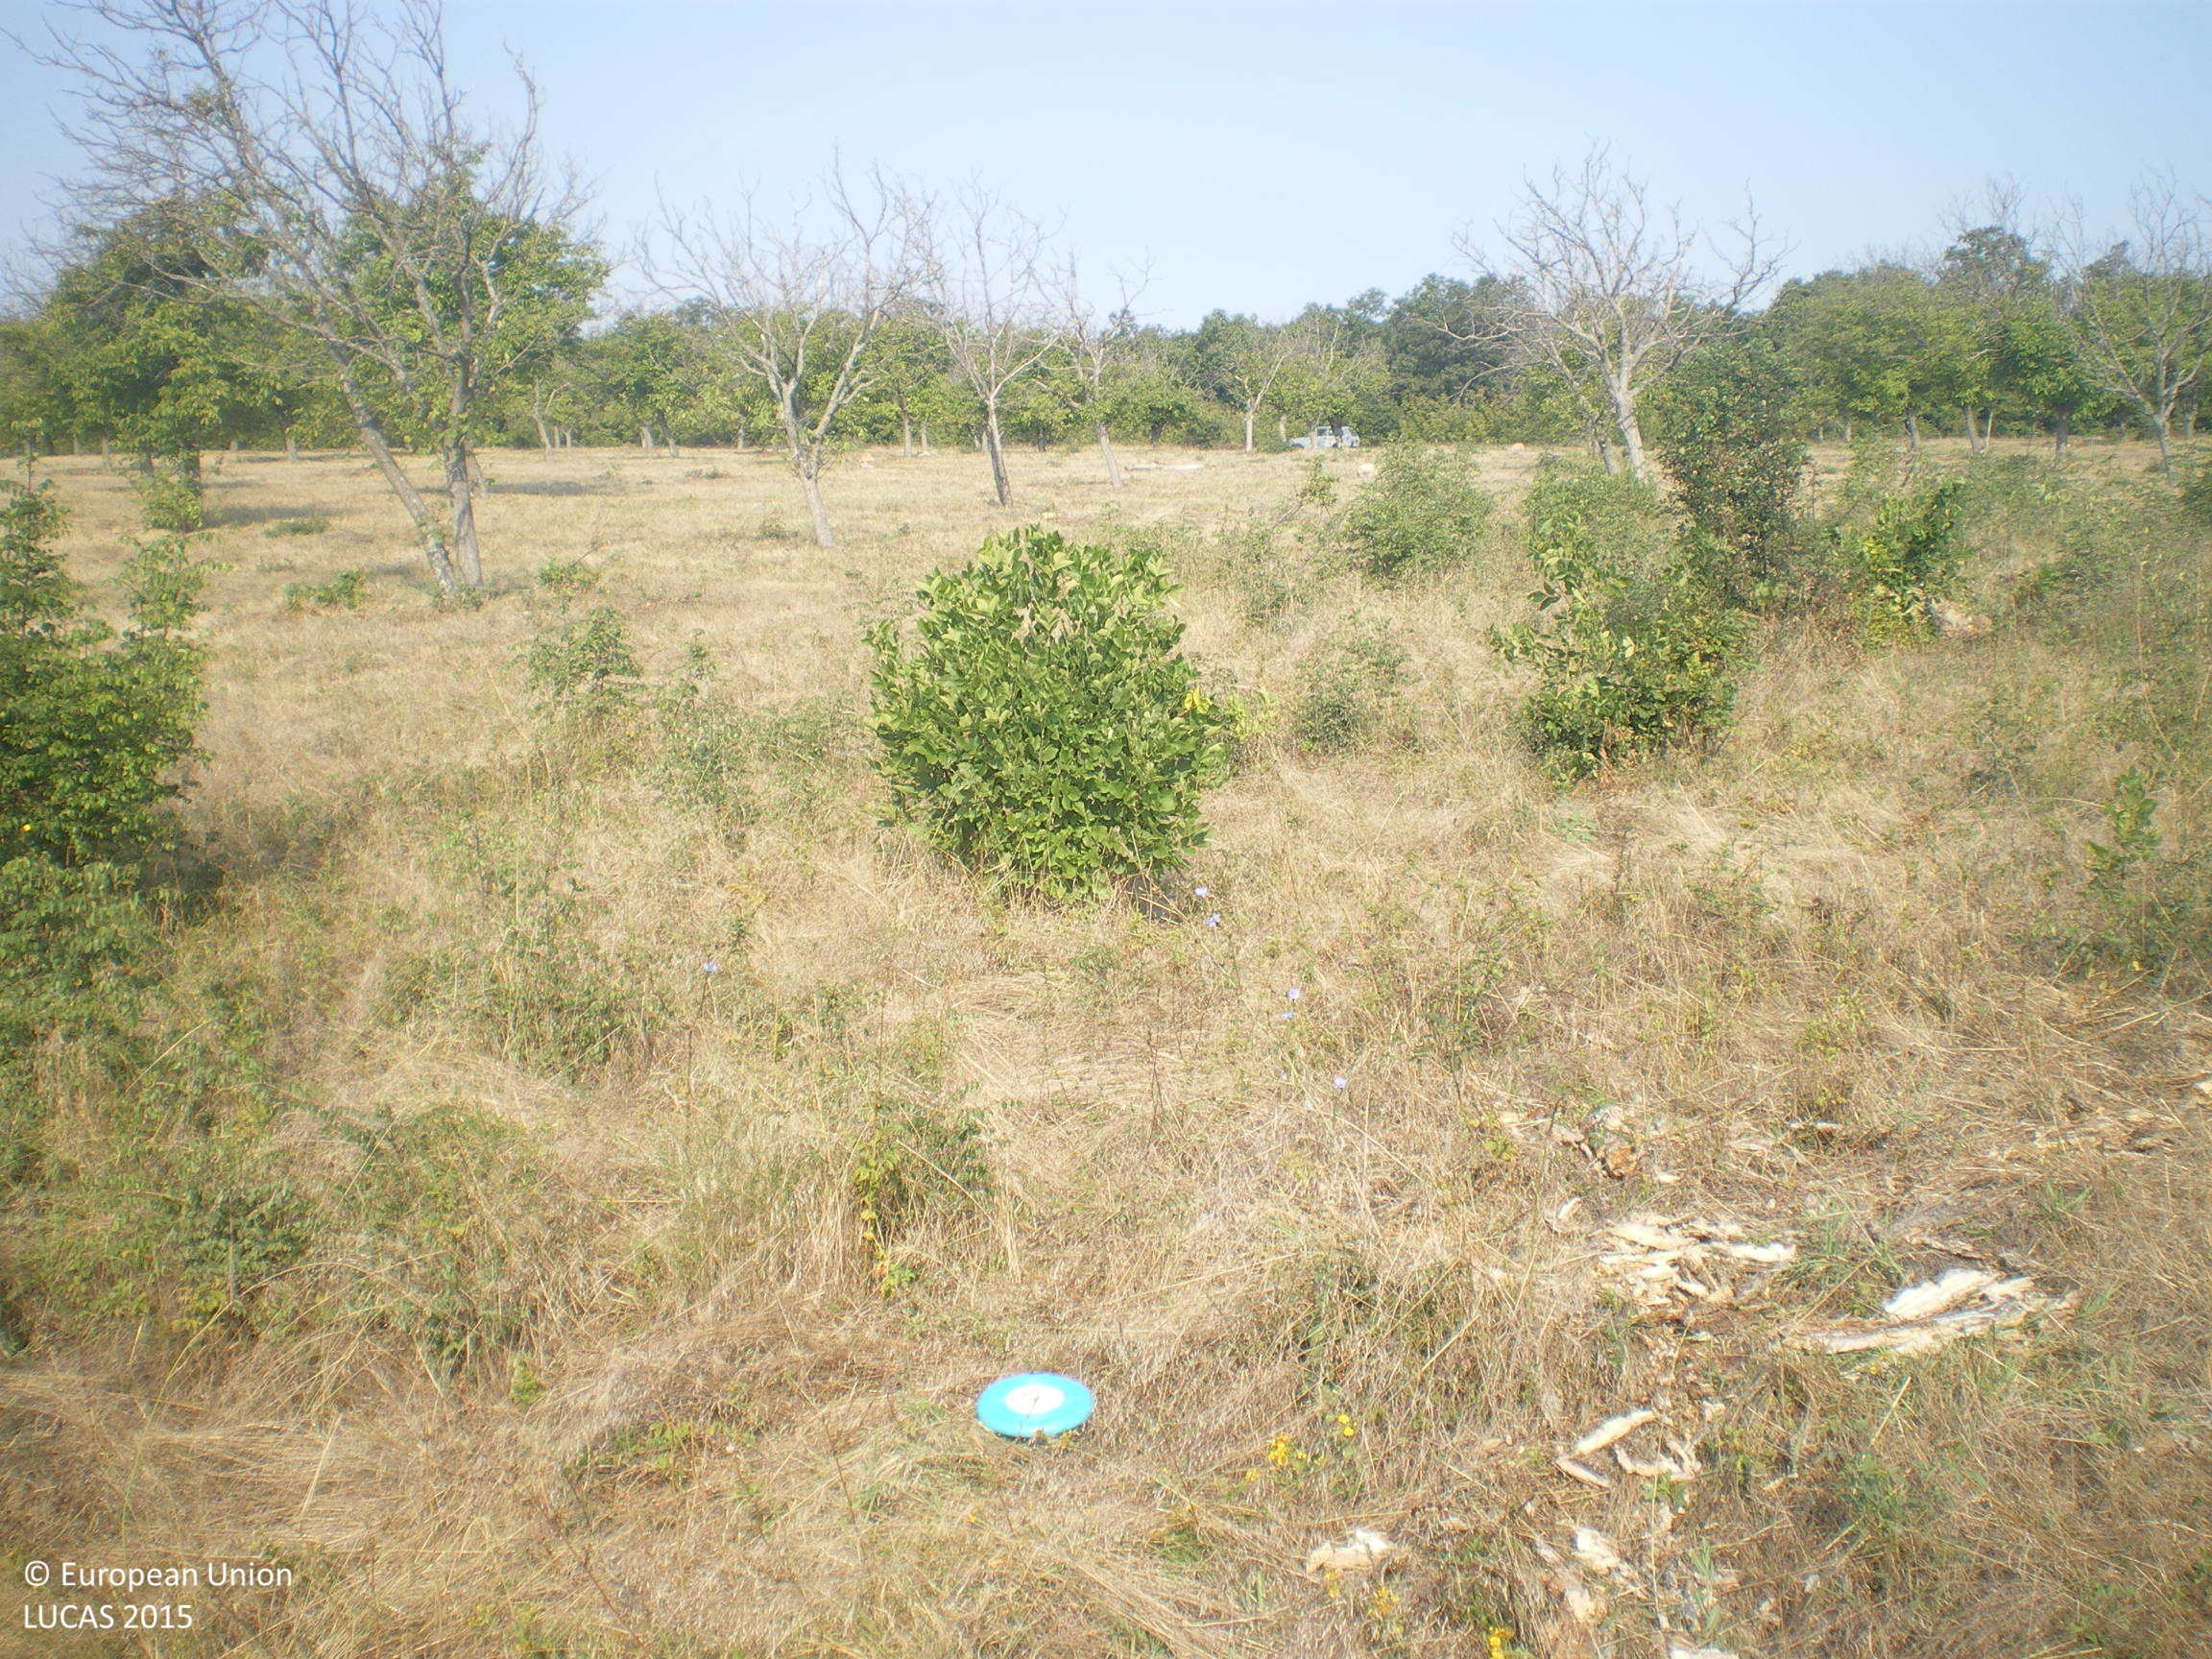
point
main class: Grassland
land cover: Grassland with sparse tree/shrub cover
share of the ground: > 75 %
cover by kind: herbaceous plants 85 %, shrubs 10 %, broadleaved forest trees 5 %
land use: Agriculture (excluding fallow land and kitchen gardens)
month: August
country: BG
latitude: 41.9851
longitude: 25.8464
